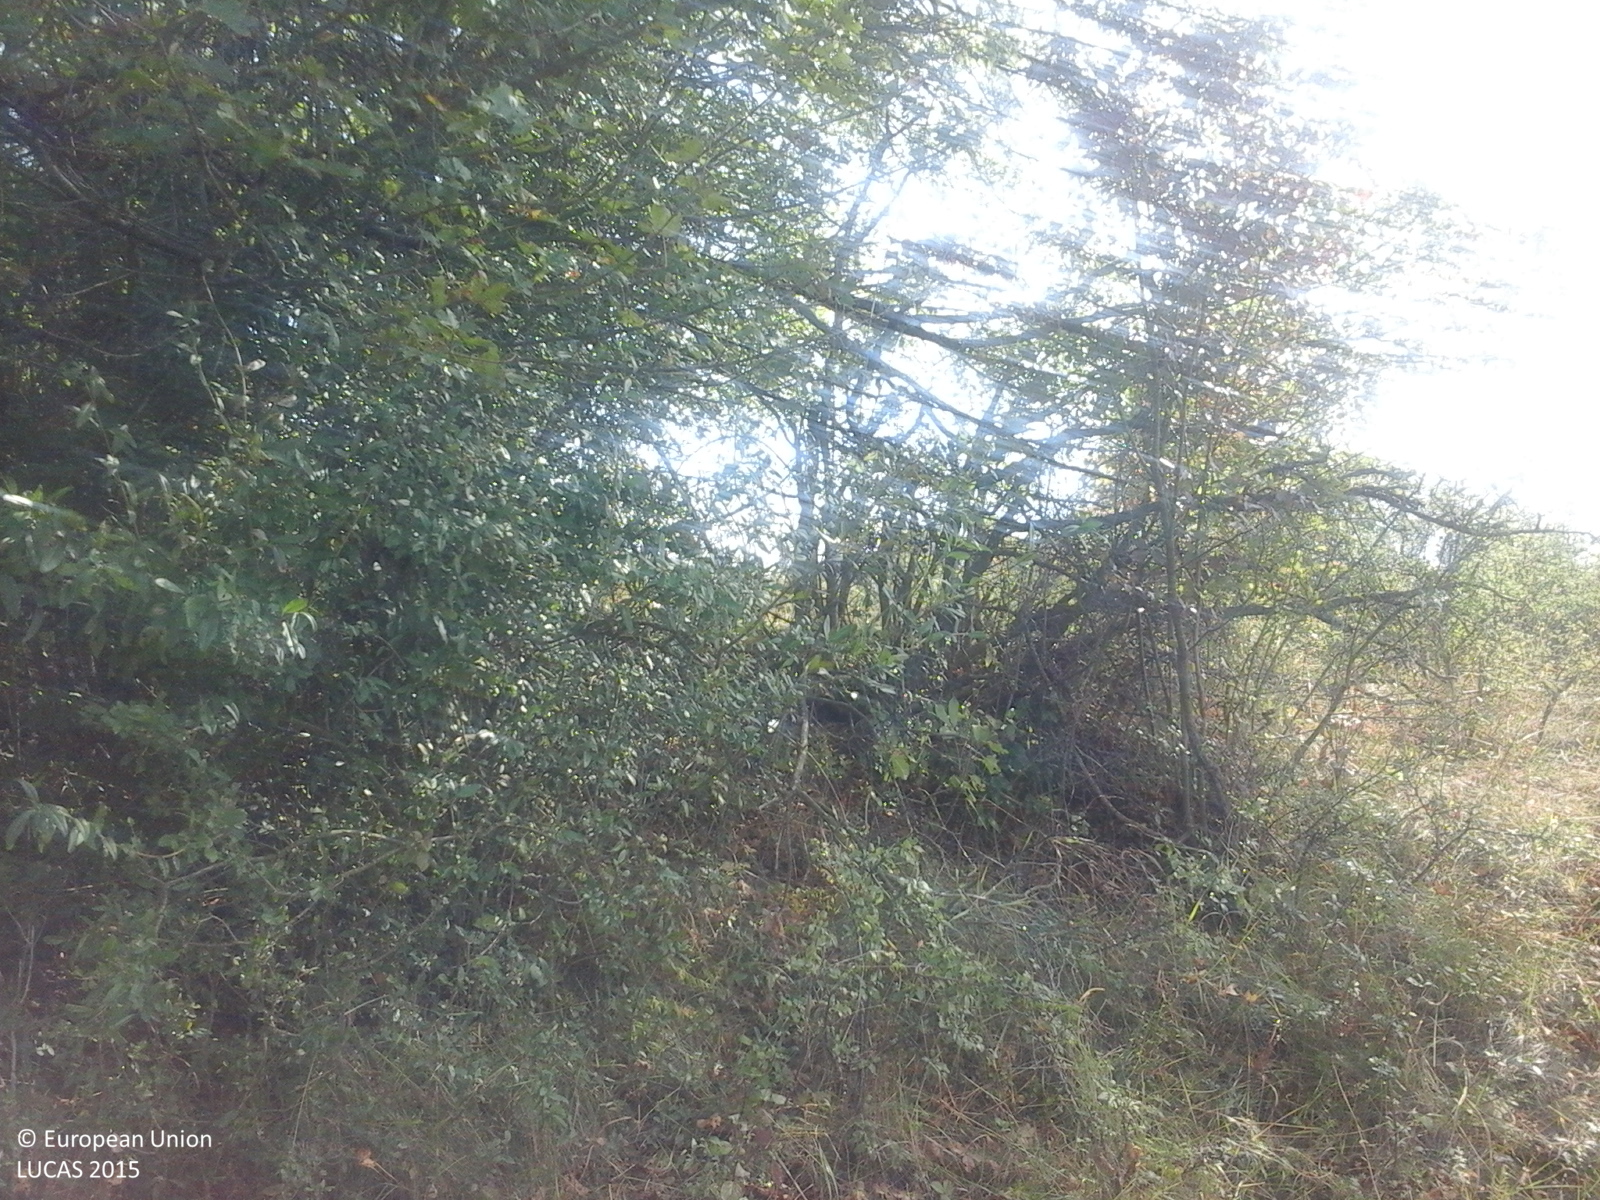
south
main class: Shrubland
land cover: Shrubland with sparse tree cover
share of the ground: > 75 %
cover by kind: shrubs 85 %, herbaceous plants 10 %, broadleaved forest trees 5 %
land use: Semi-natural and natural areas not in use
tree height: < 5 m
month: September
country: RO
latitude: 47.1420
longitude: 23.4279
